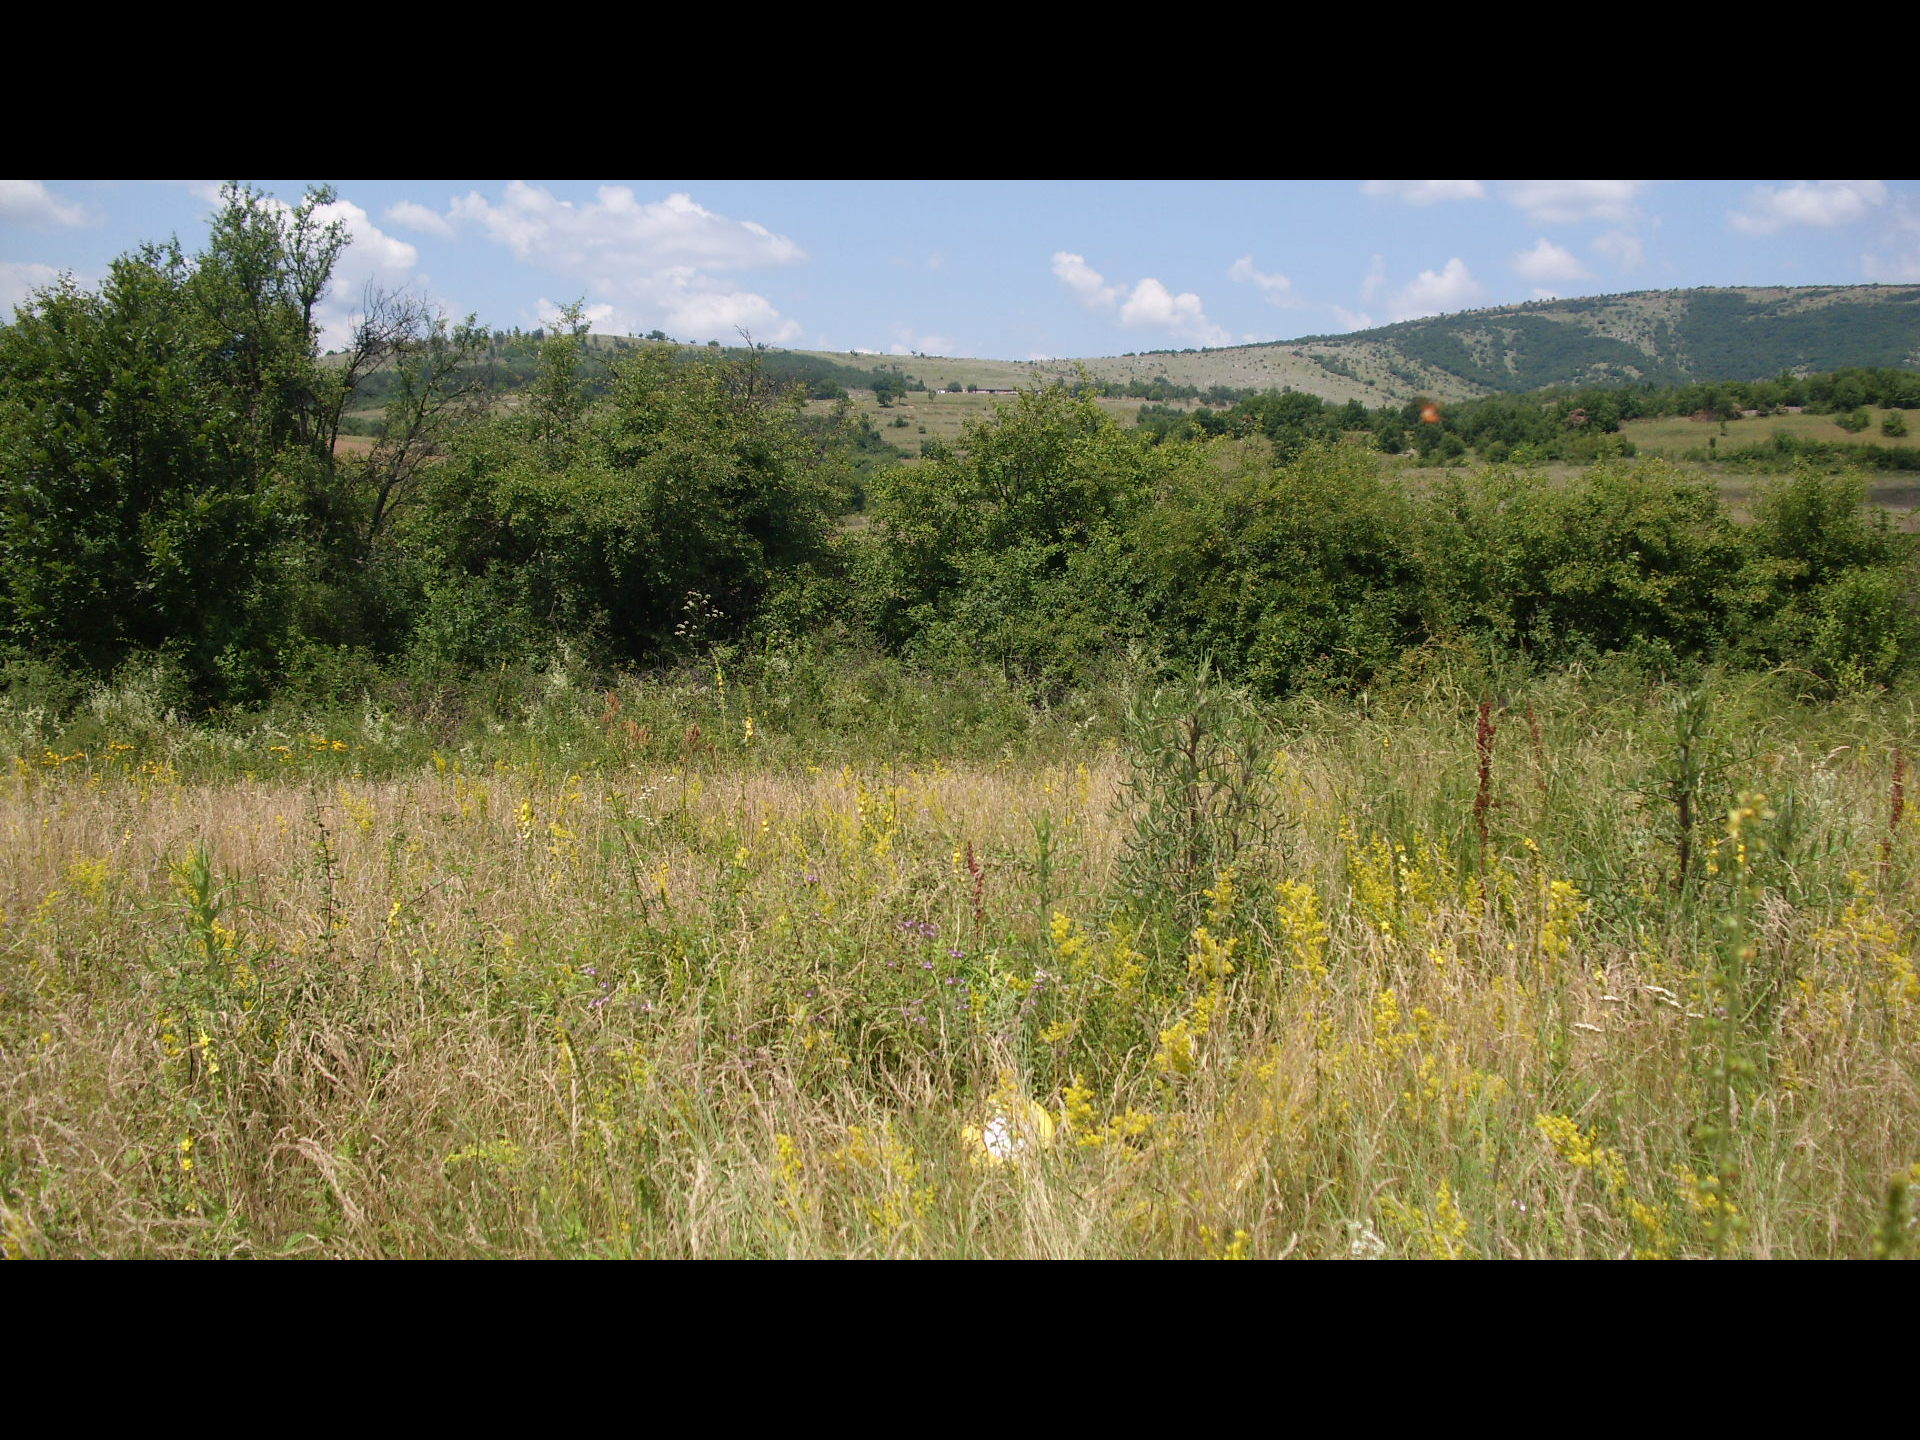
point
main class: Grassland
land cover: Grassland with sparse tree/shrub cover
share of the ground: > 75 %
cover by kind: herbaceous plants 85 %, shrubs 10 %, broadleaved forest trees 5 %
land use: Agriculture (excluding fallow land and kitchen gardens)
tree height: < 5 m
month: July
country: BG
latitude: 43.3963
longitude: 23.0375
